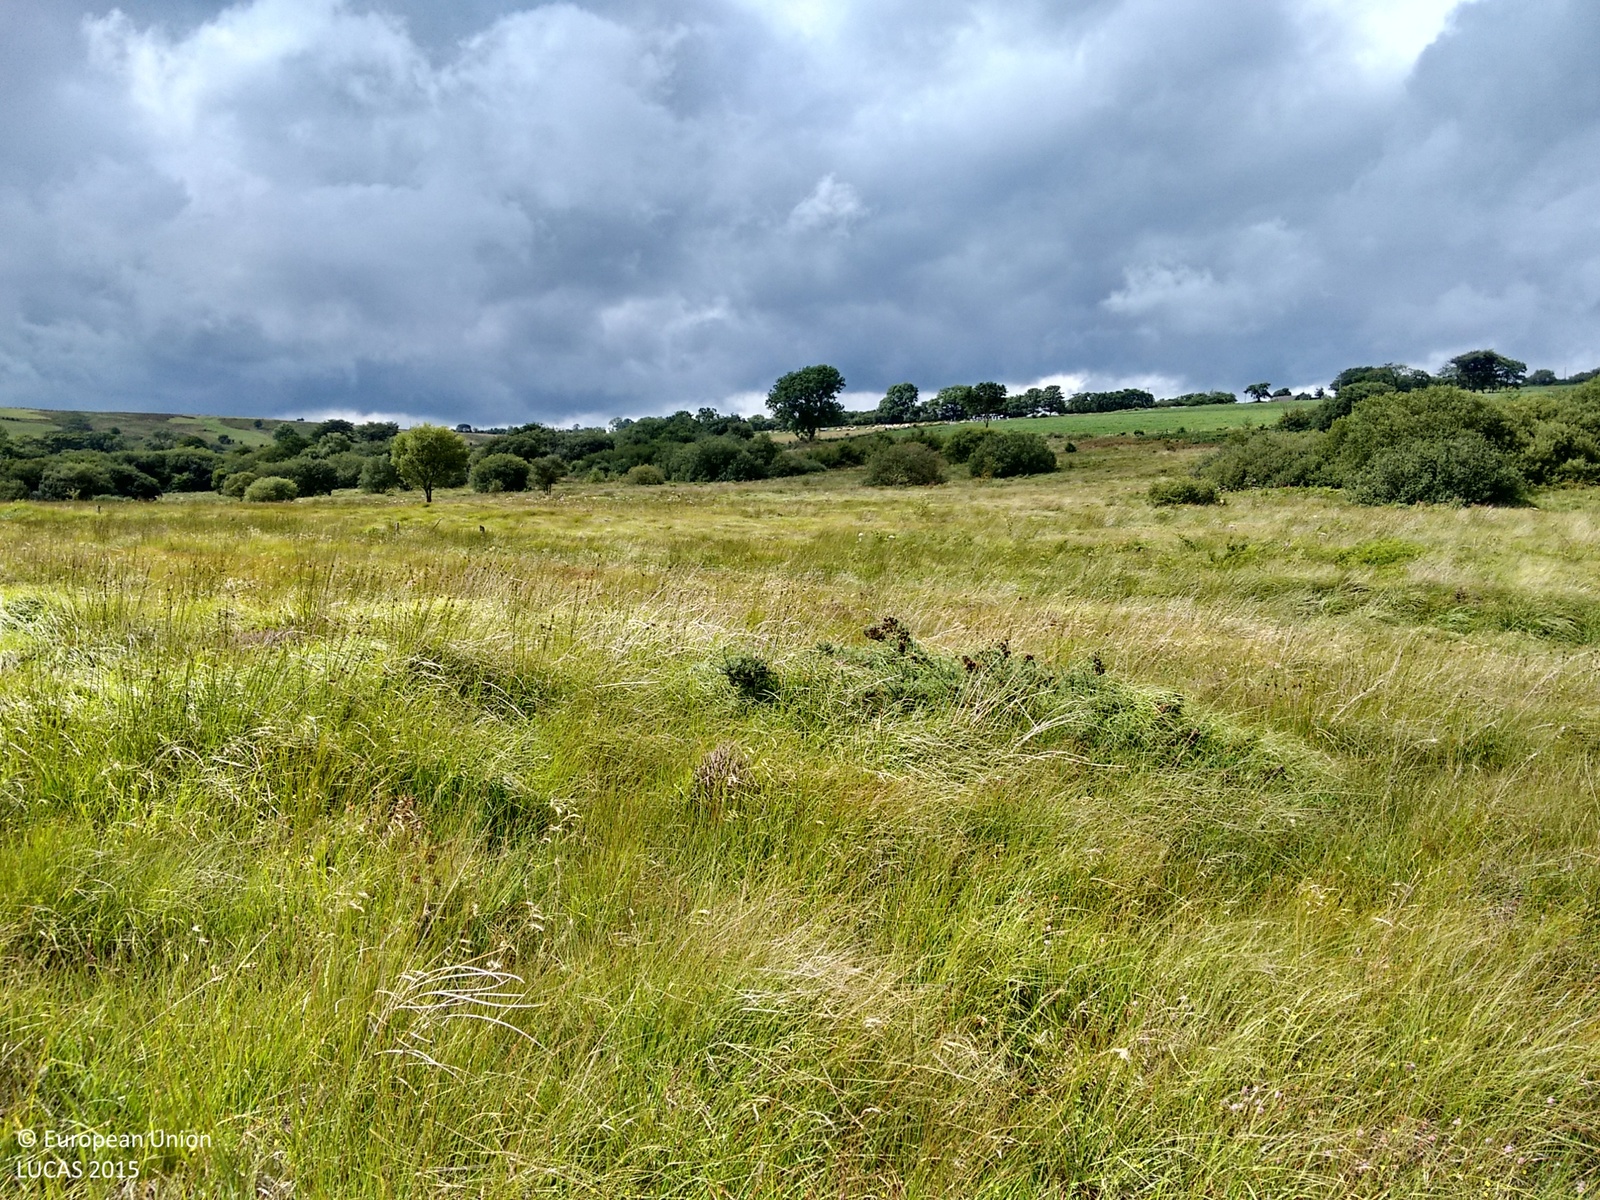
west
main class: Grassland
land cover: Grassland without tree/shrub cover
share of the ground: > 75 %
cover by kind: herbaceous plants 100 %
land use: Agriculture (excluding fallow land and kitchen gardens)
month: August
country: GB
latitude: 51.9527
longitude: -4.0793
